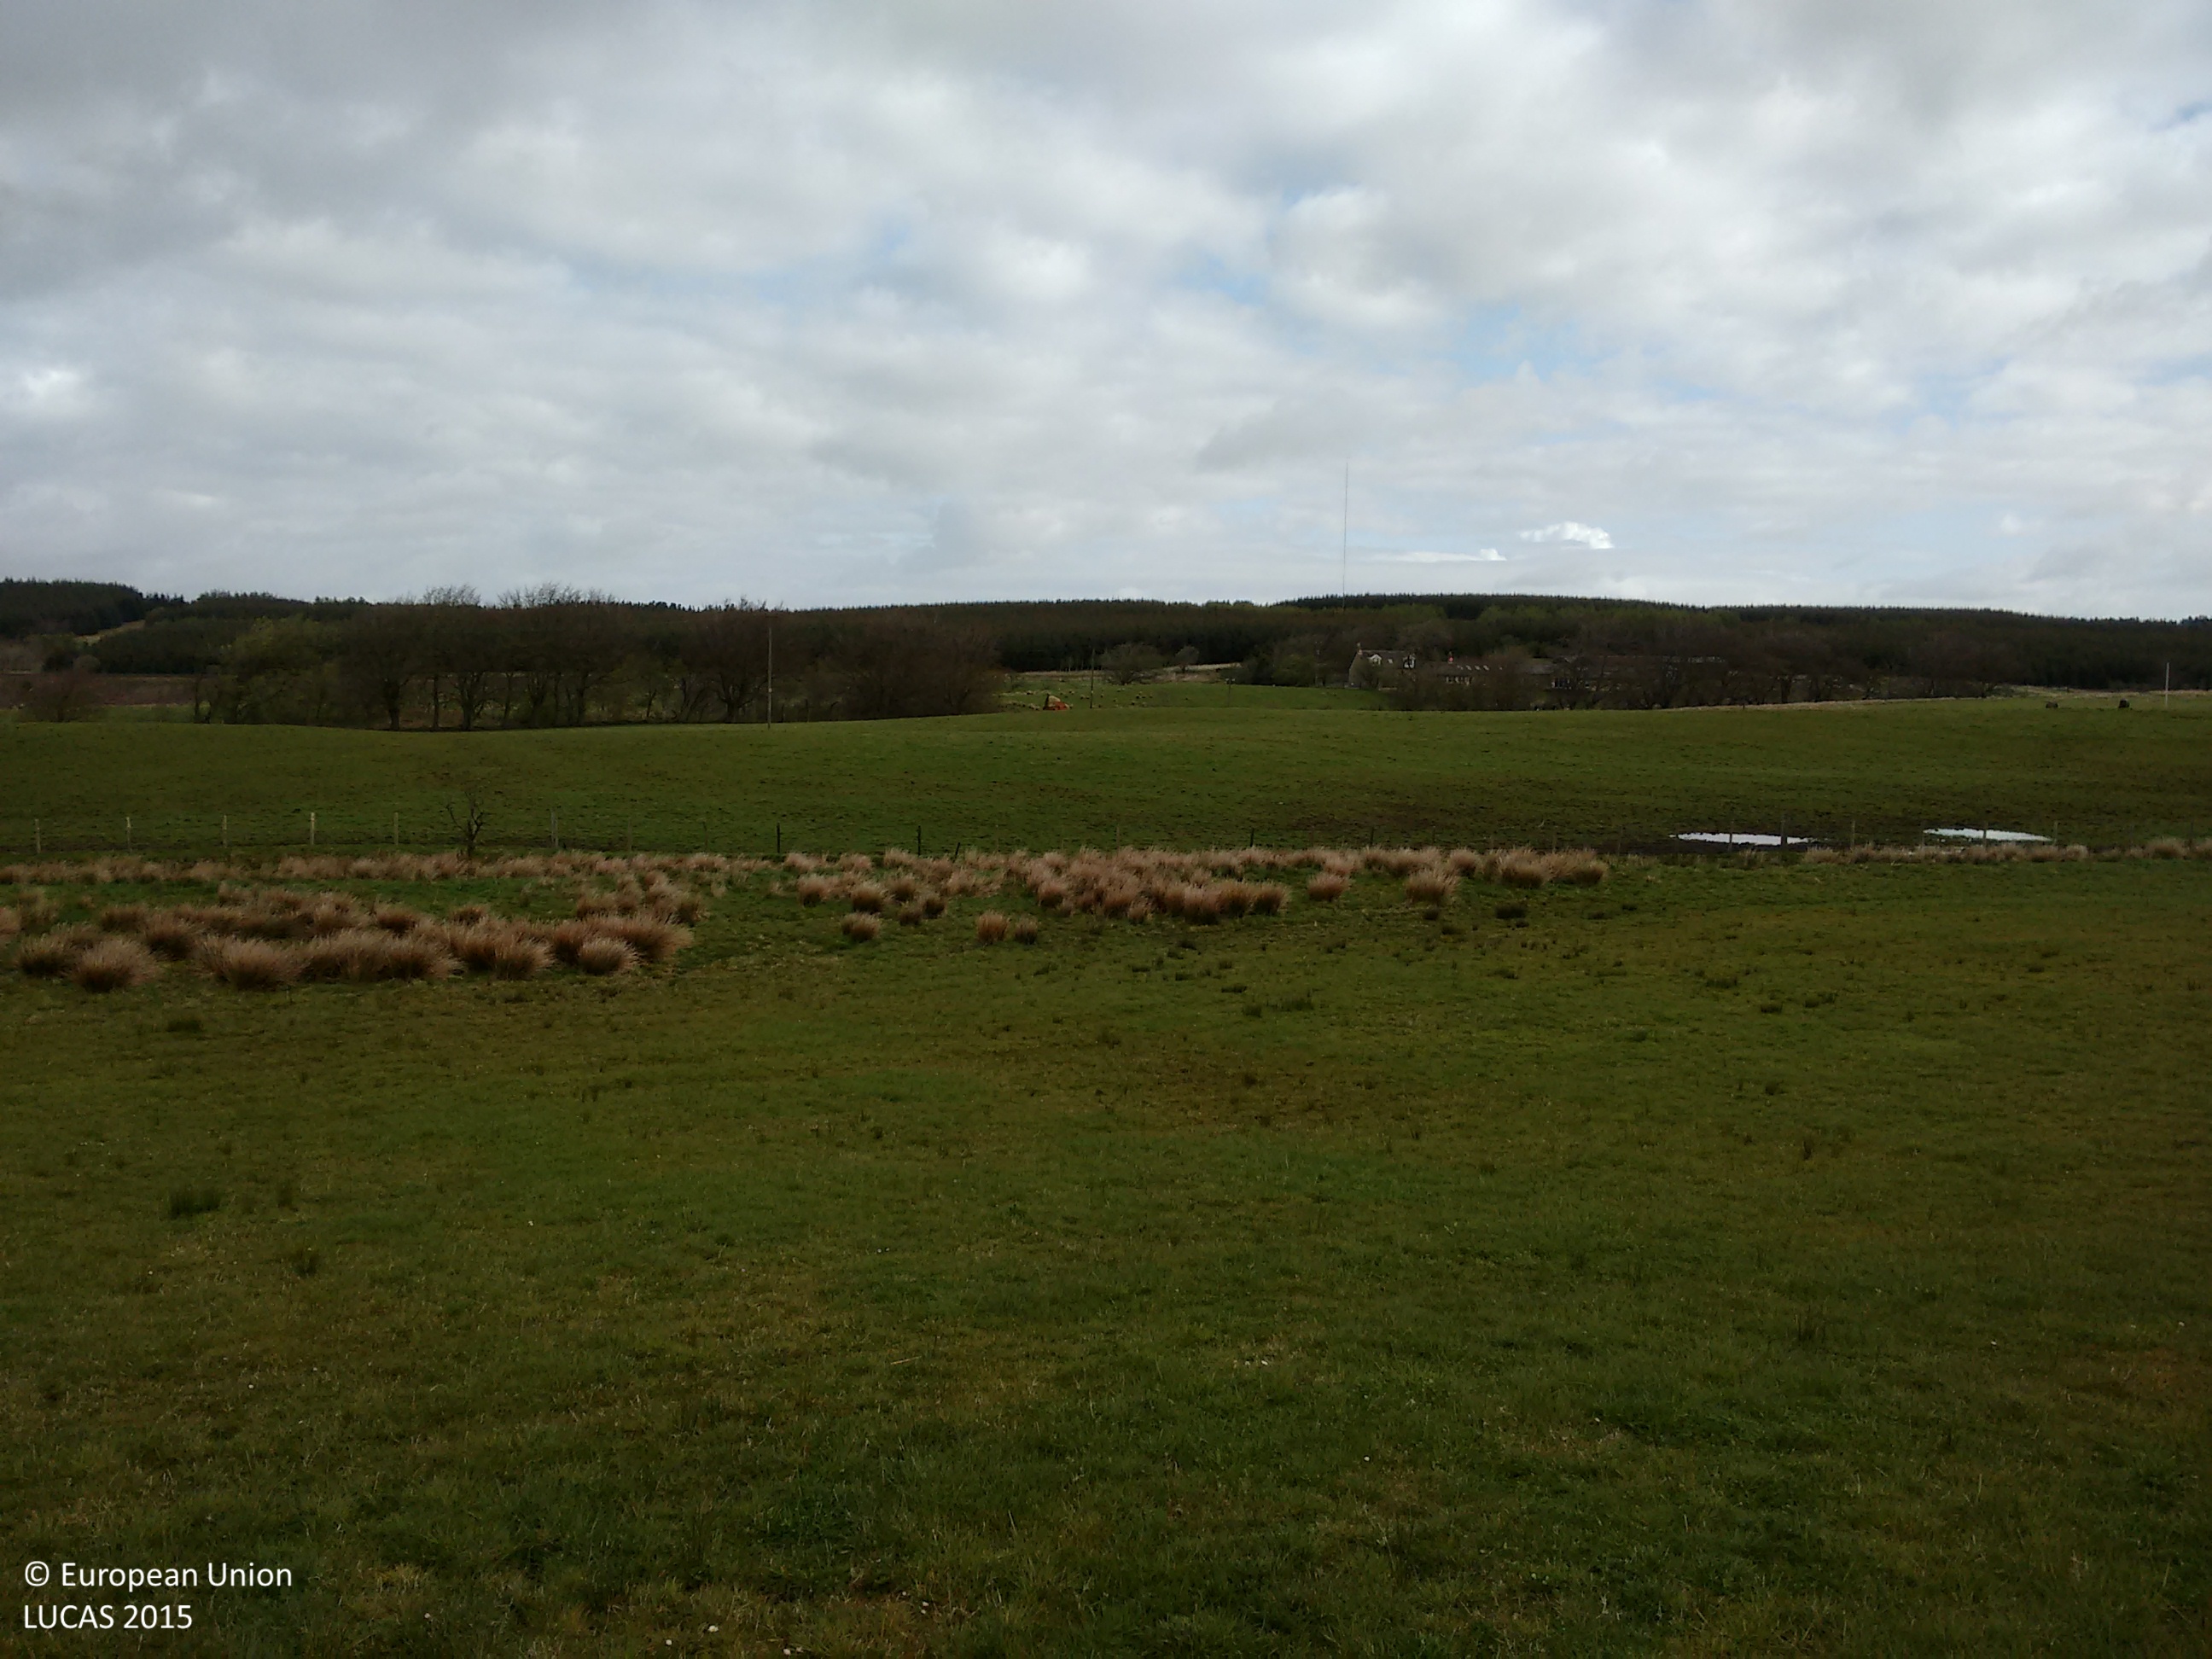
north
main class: Grassland
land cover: Grassland without tree/shrub cover
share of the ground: > 75 %
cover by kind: herbaceous plants 100 %
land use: Agriculture (excluding fallow land and kitchen gardens)
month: May
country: GB
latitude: 55.8250
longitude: -3.7630
